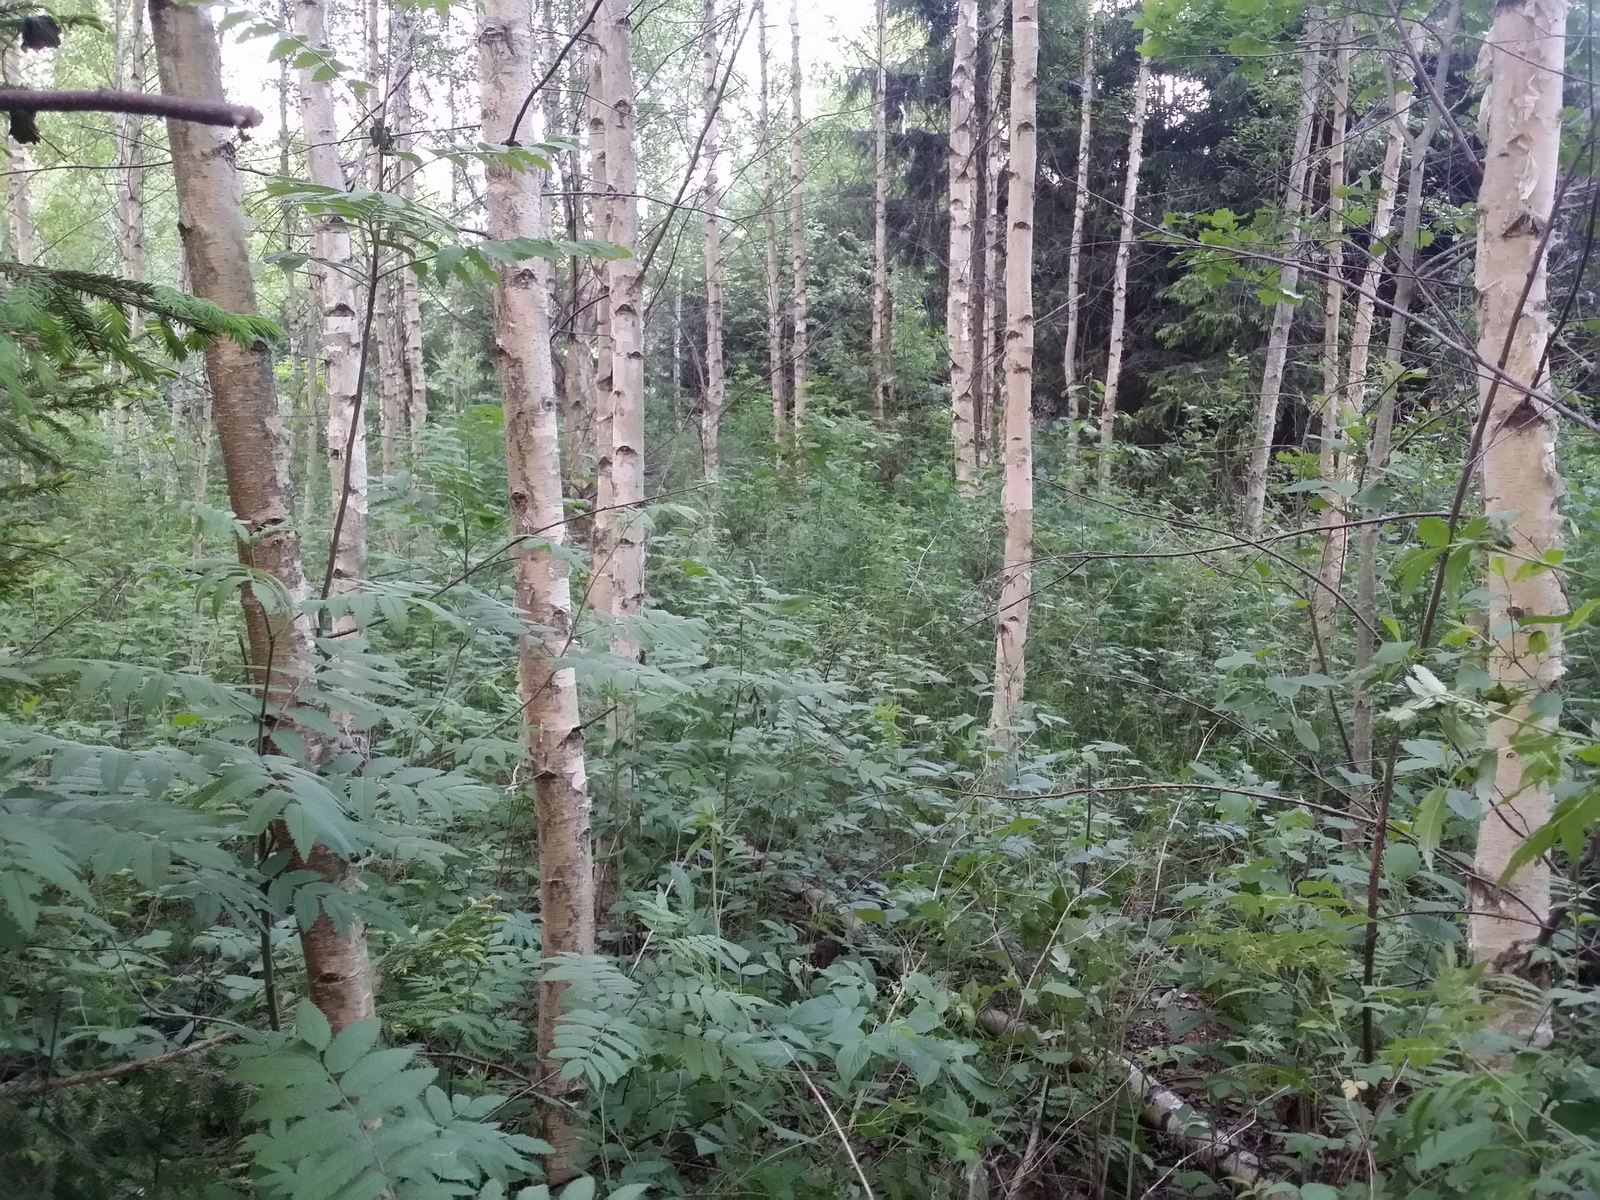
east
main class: Woodland
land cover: Spruce dominated mixed woodland
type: hemiboreal forest and nemoral coniferous forest and mixed broadleaved-coniferous forest
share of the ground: > 75 %
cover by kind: broadleaved forest trees 60 %, coniferous forest trees 20 %, shrubs 10 %, herbaceous plants 10 %
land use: Forestry
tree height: > 5 m
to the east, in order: Spruce dominated mixed woodland
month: June
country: LV
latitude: 57.3052
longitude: 26.5960
